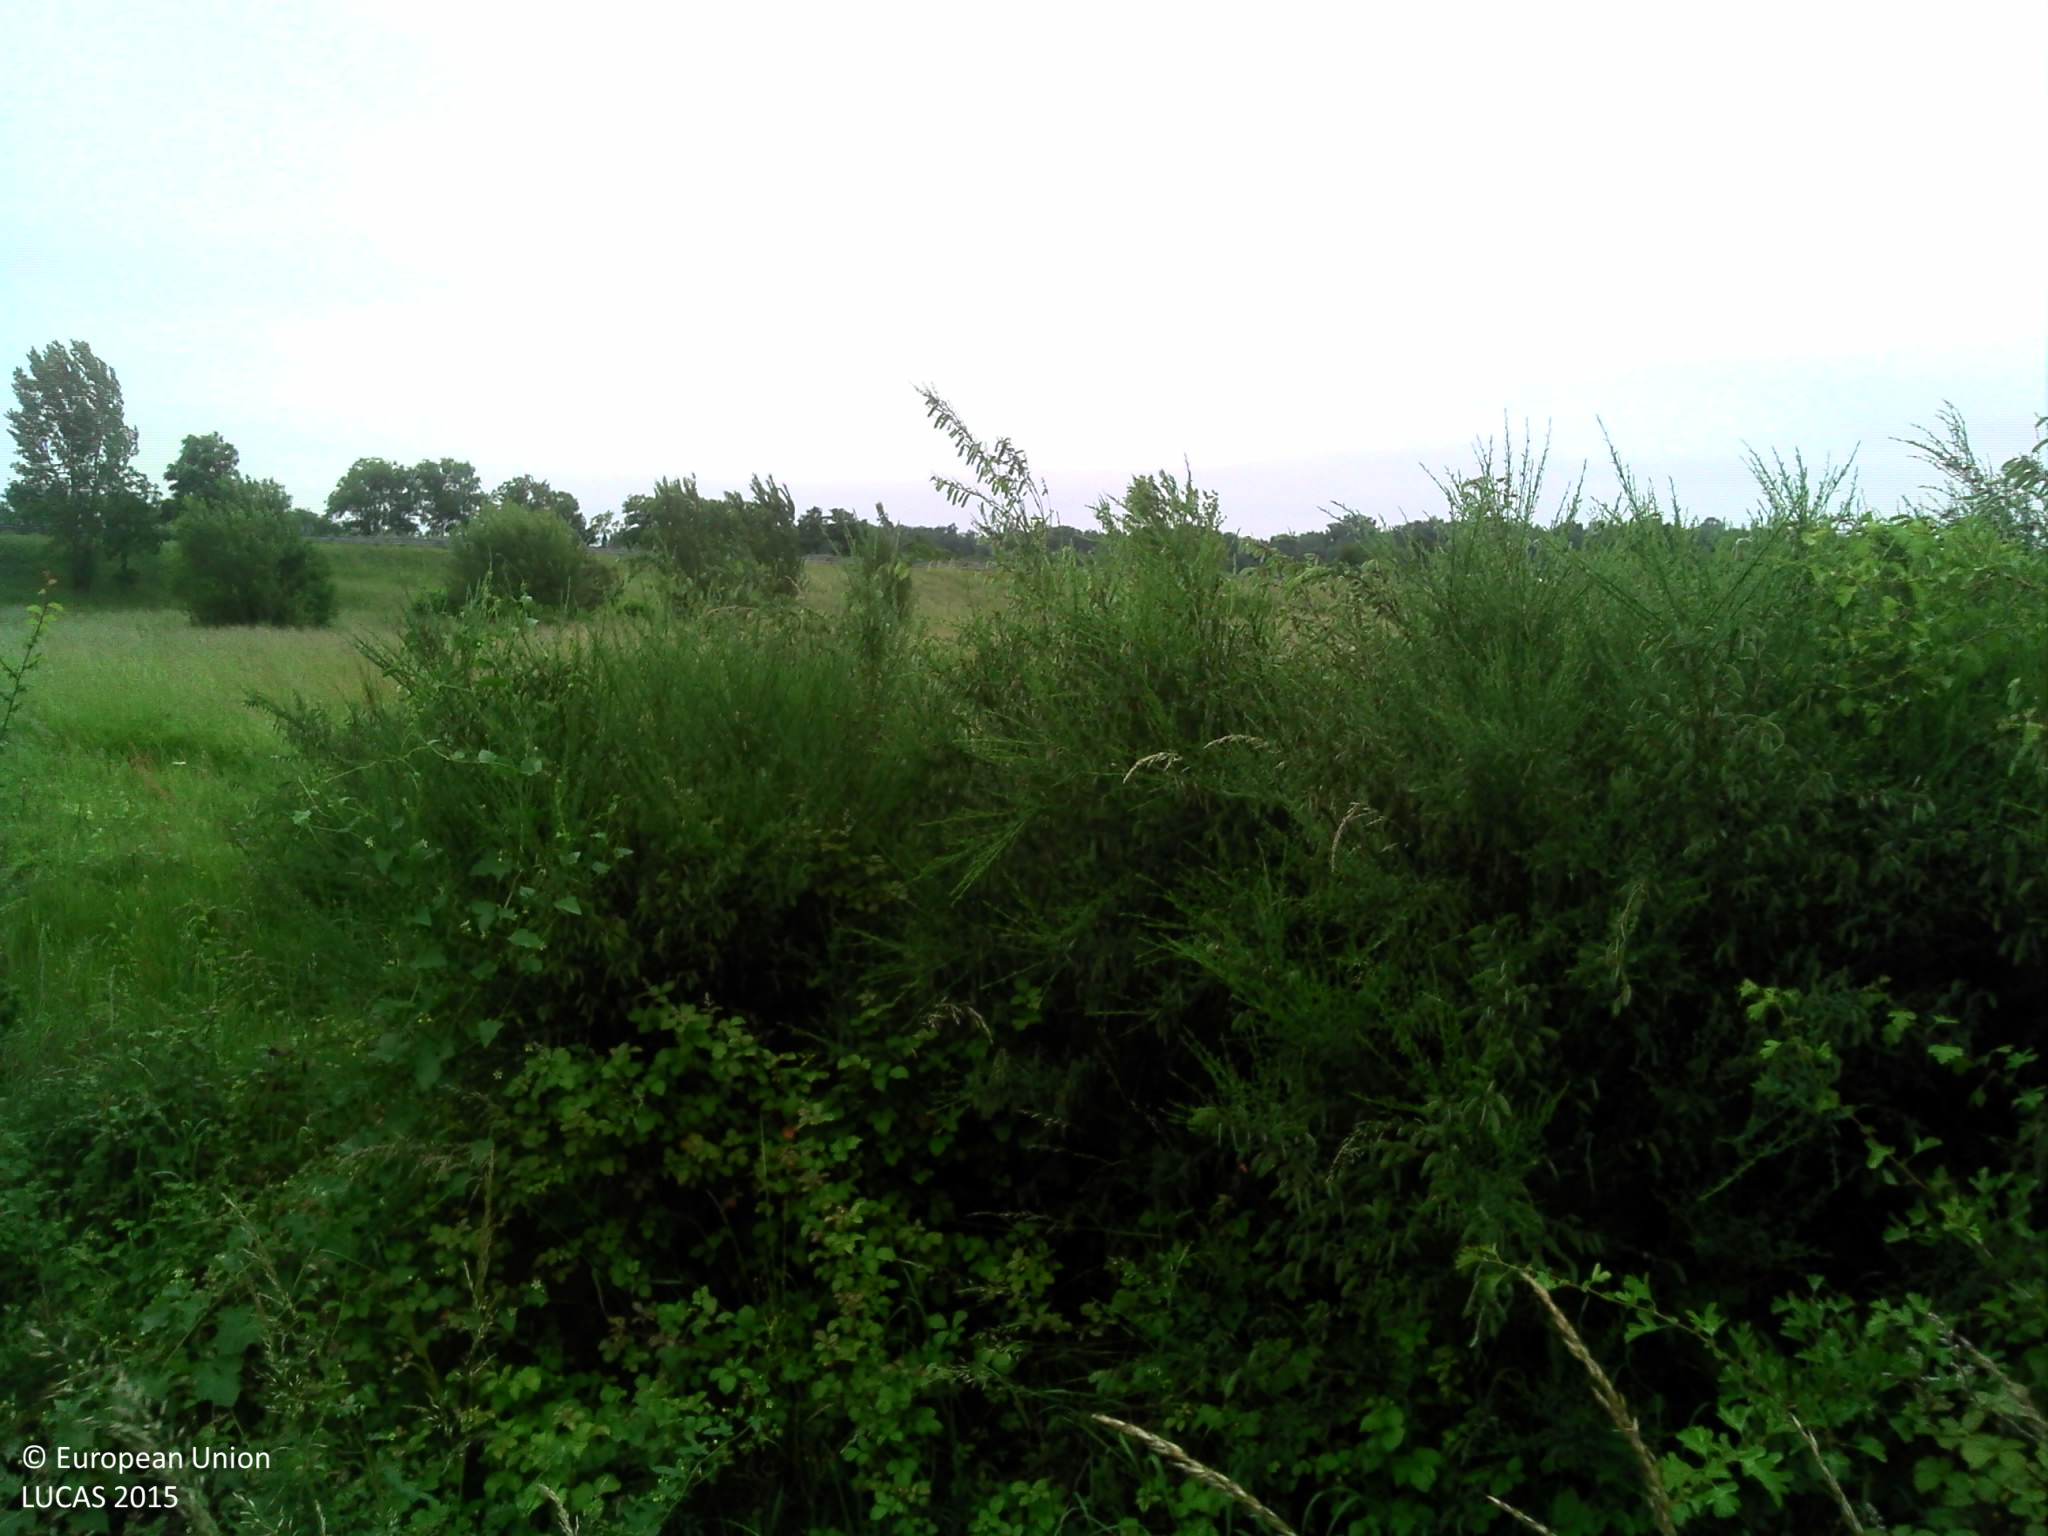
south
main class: Shrubland
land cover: Shrubland with sparse tree cover
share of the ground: > 75 %
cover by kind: shrubs 95 %, broadleaved forest trees 5 %
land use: Fallow land
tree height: < 5 m
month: May
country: FR
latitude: 43.7653
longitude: 1.7175
